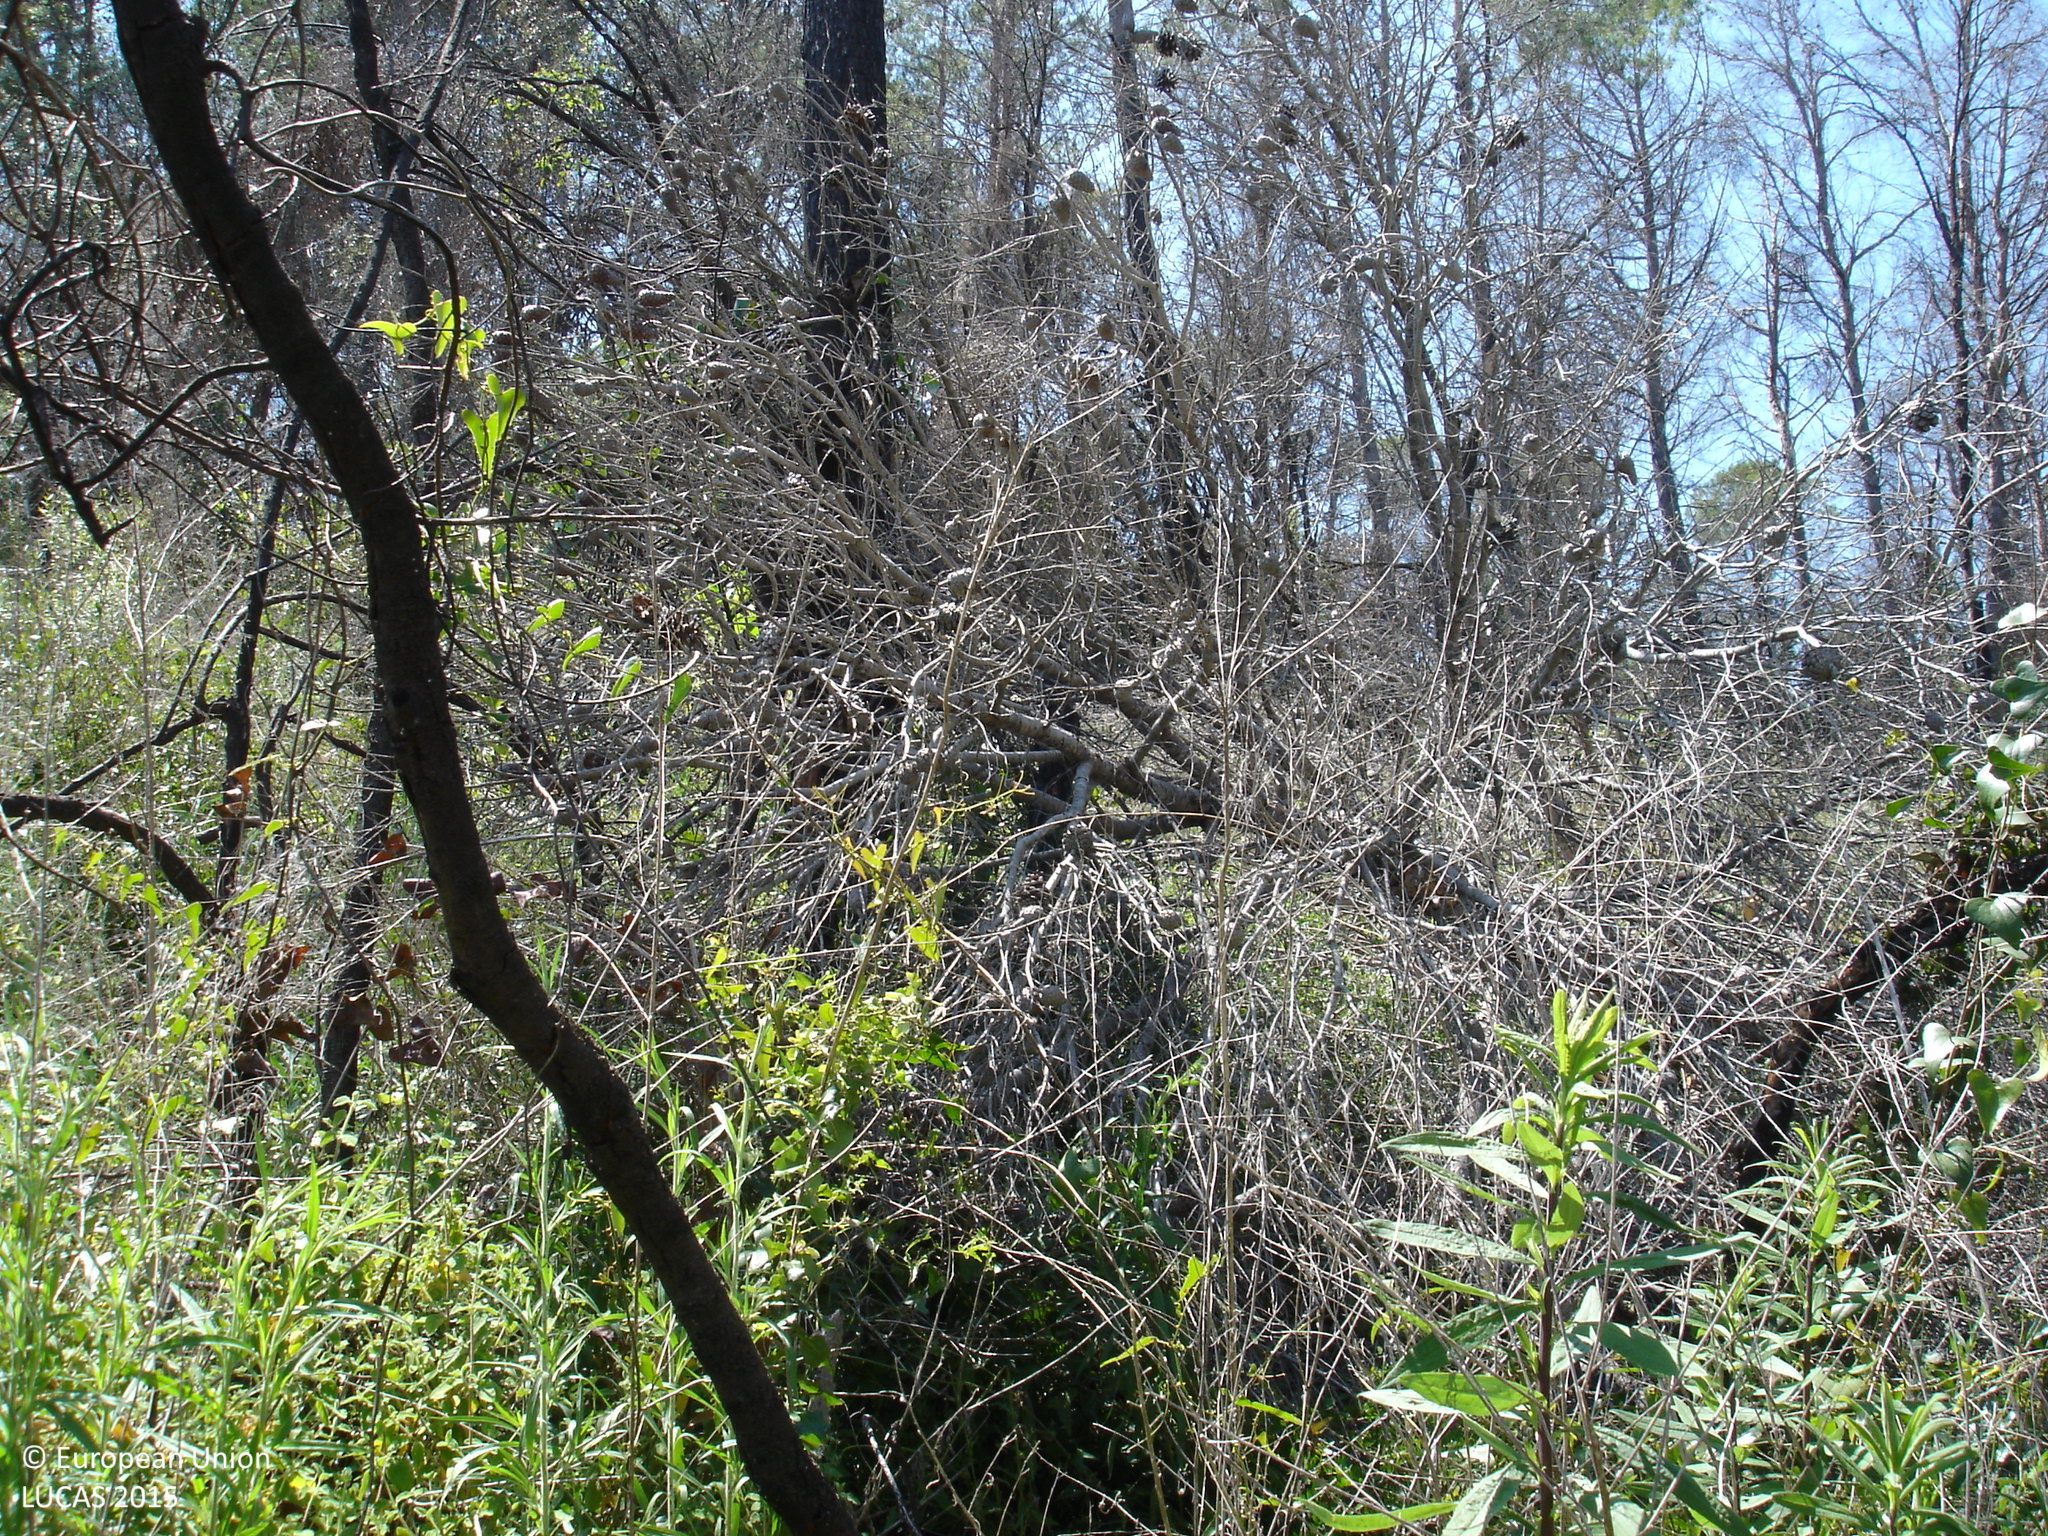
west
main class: Woodland
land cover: Pine dominated coniferous woodland
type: coniferous forest of the mediterranean region
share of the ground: 25 - 50 %
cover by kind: shrubs 55 %, coniferous forest trees 45 %
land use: Forestry
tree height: > 5 m
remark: Burnt area
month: May
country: ES
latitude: 42.0669
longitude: 2.9937
